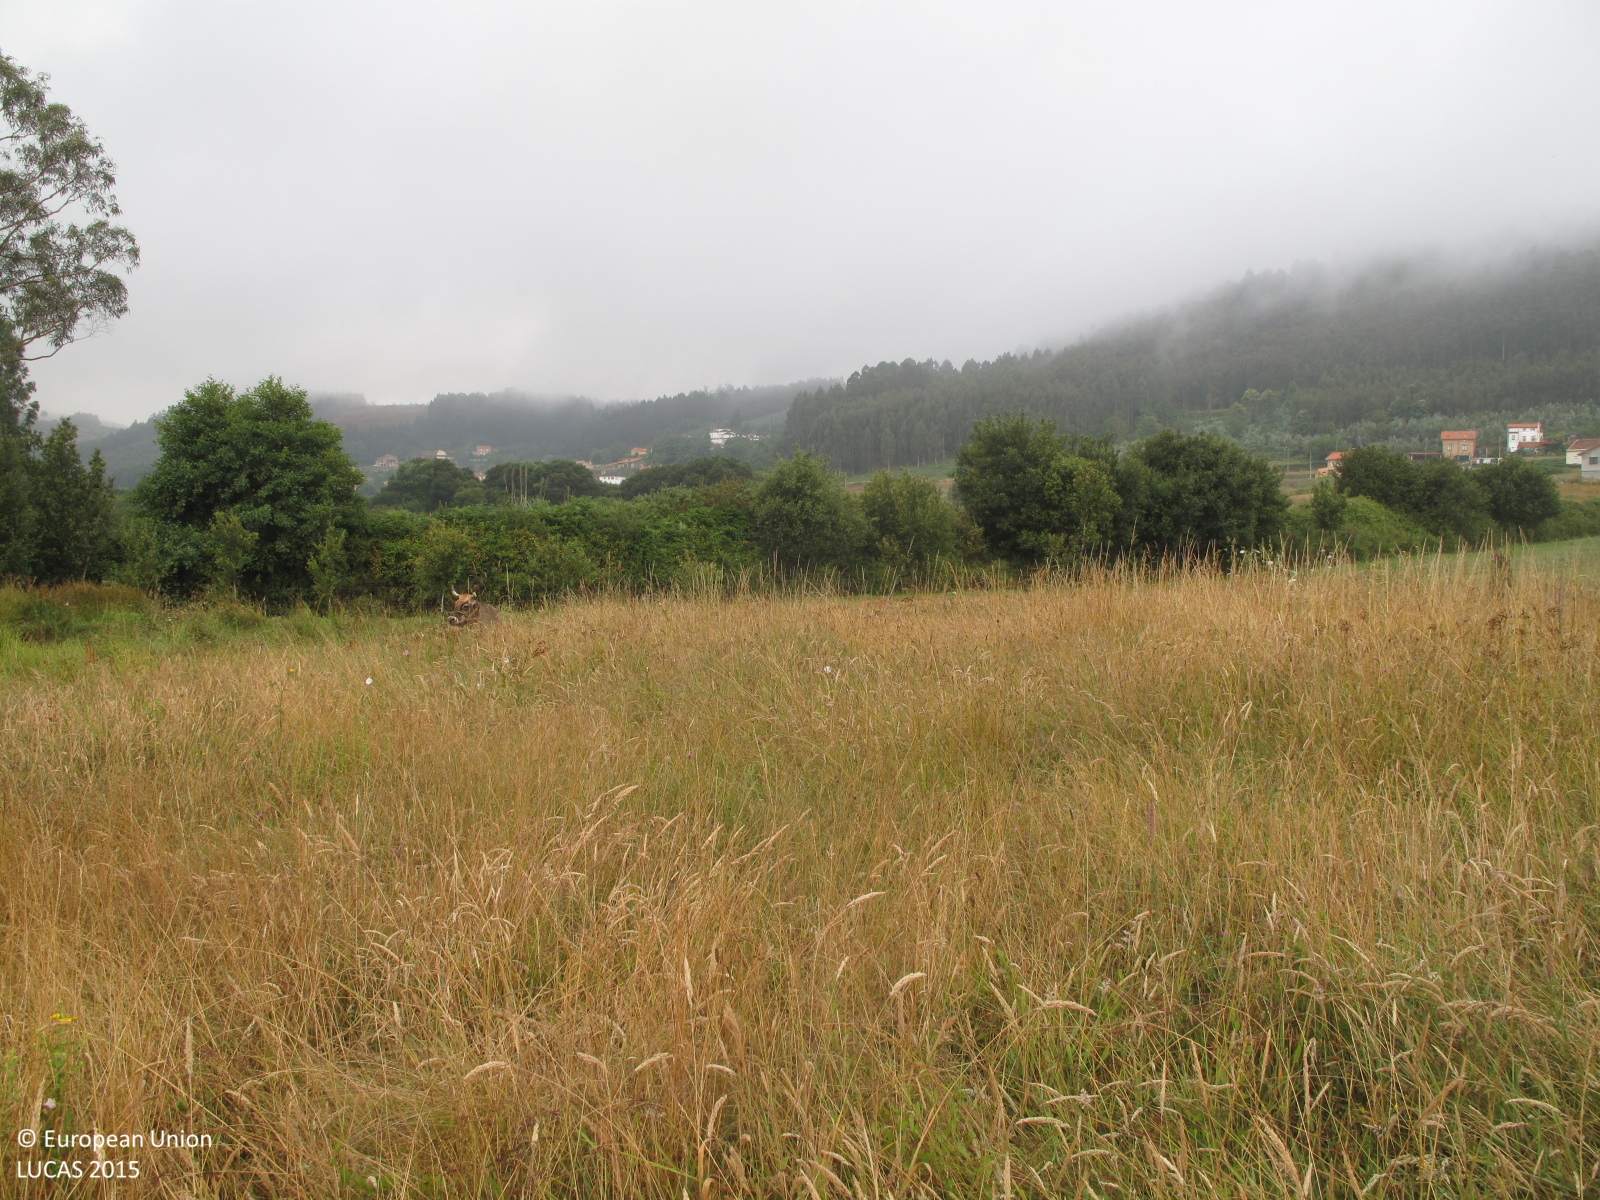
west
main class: Grassland
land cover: Grassland without tree/shrub cover
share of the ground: > 75 %
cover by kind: herbaceous plants 100 %
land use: Agriculture (excluding fallow land and kitchen gardens)
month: July
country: ES
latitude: 43.5307
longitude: -8.2310
